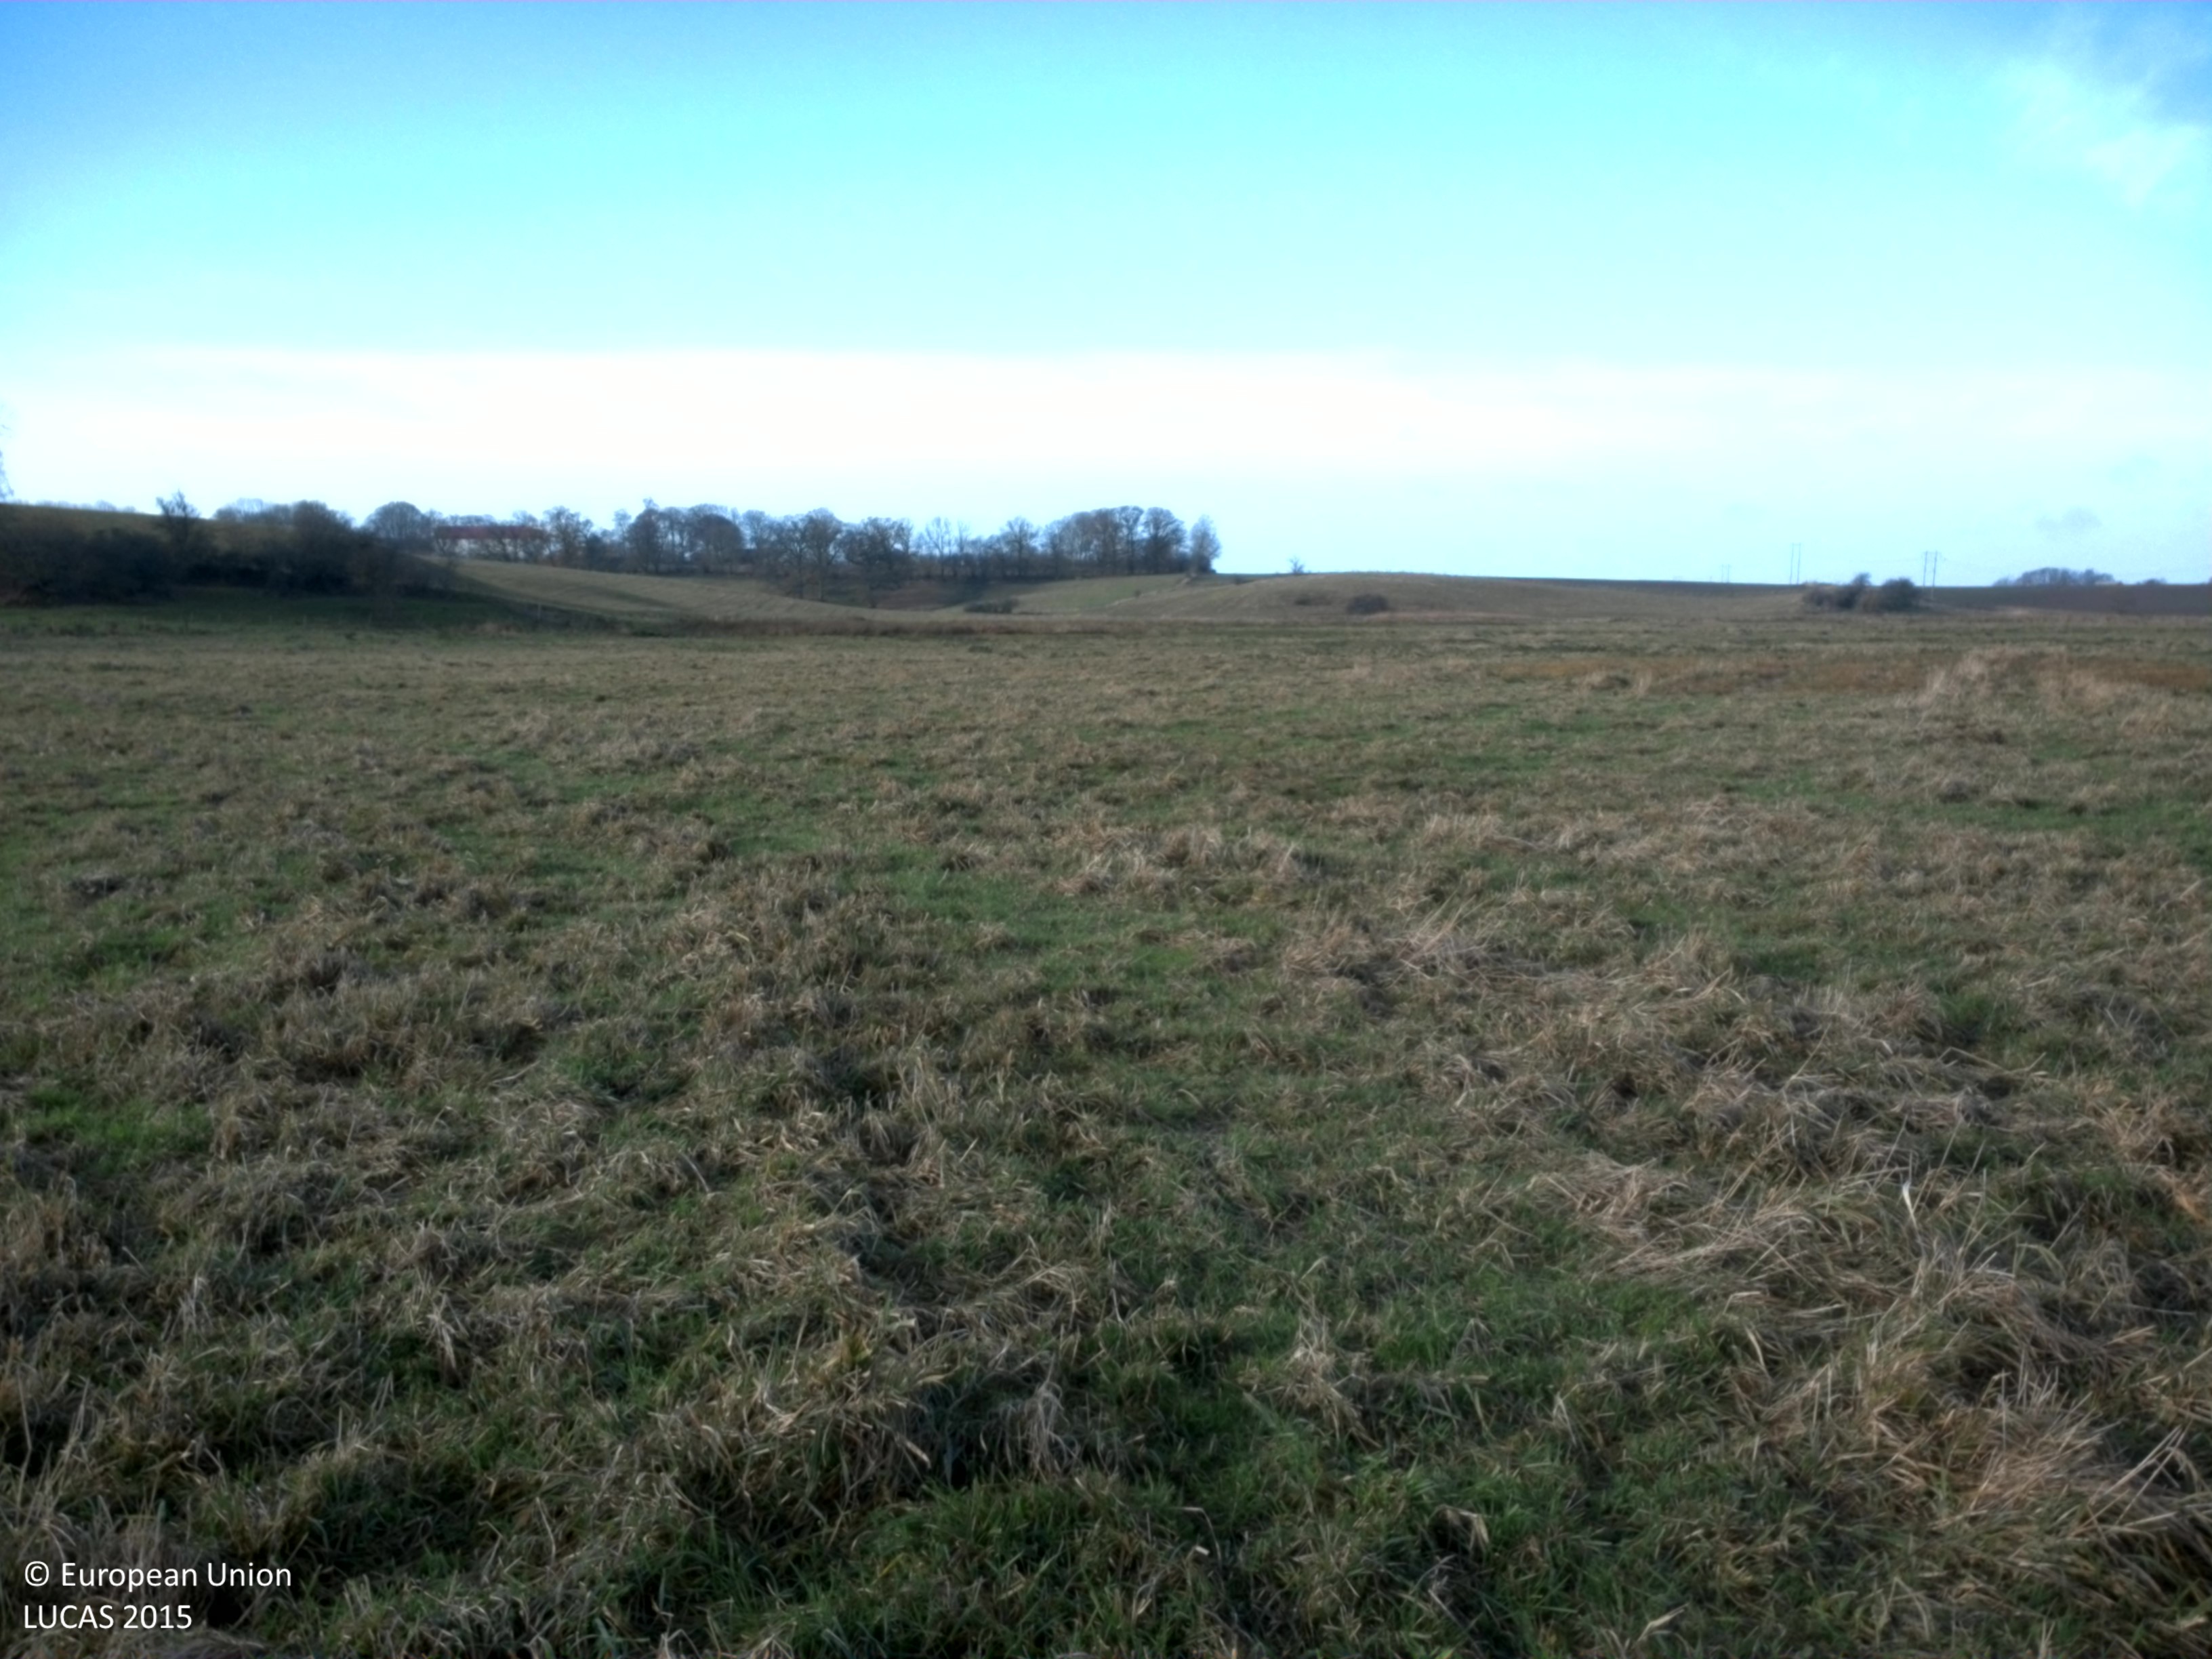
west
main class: Grassland
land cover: Grassland without tree/shrub cover
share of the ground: > 75 %
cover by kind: herbaceous plants 100 %
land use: Agriculture (excluding fallow land and kitchen gardens)
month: November
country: SE
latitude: 56.1510
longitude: 13.0721
